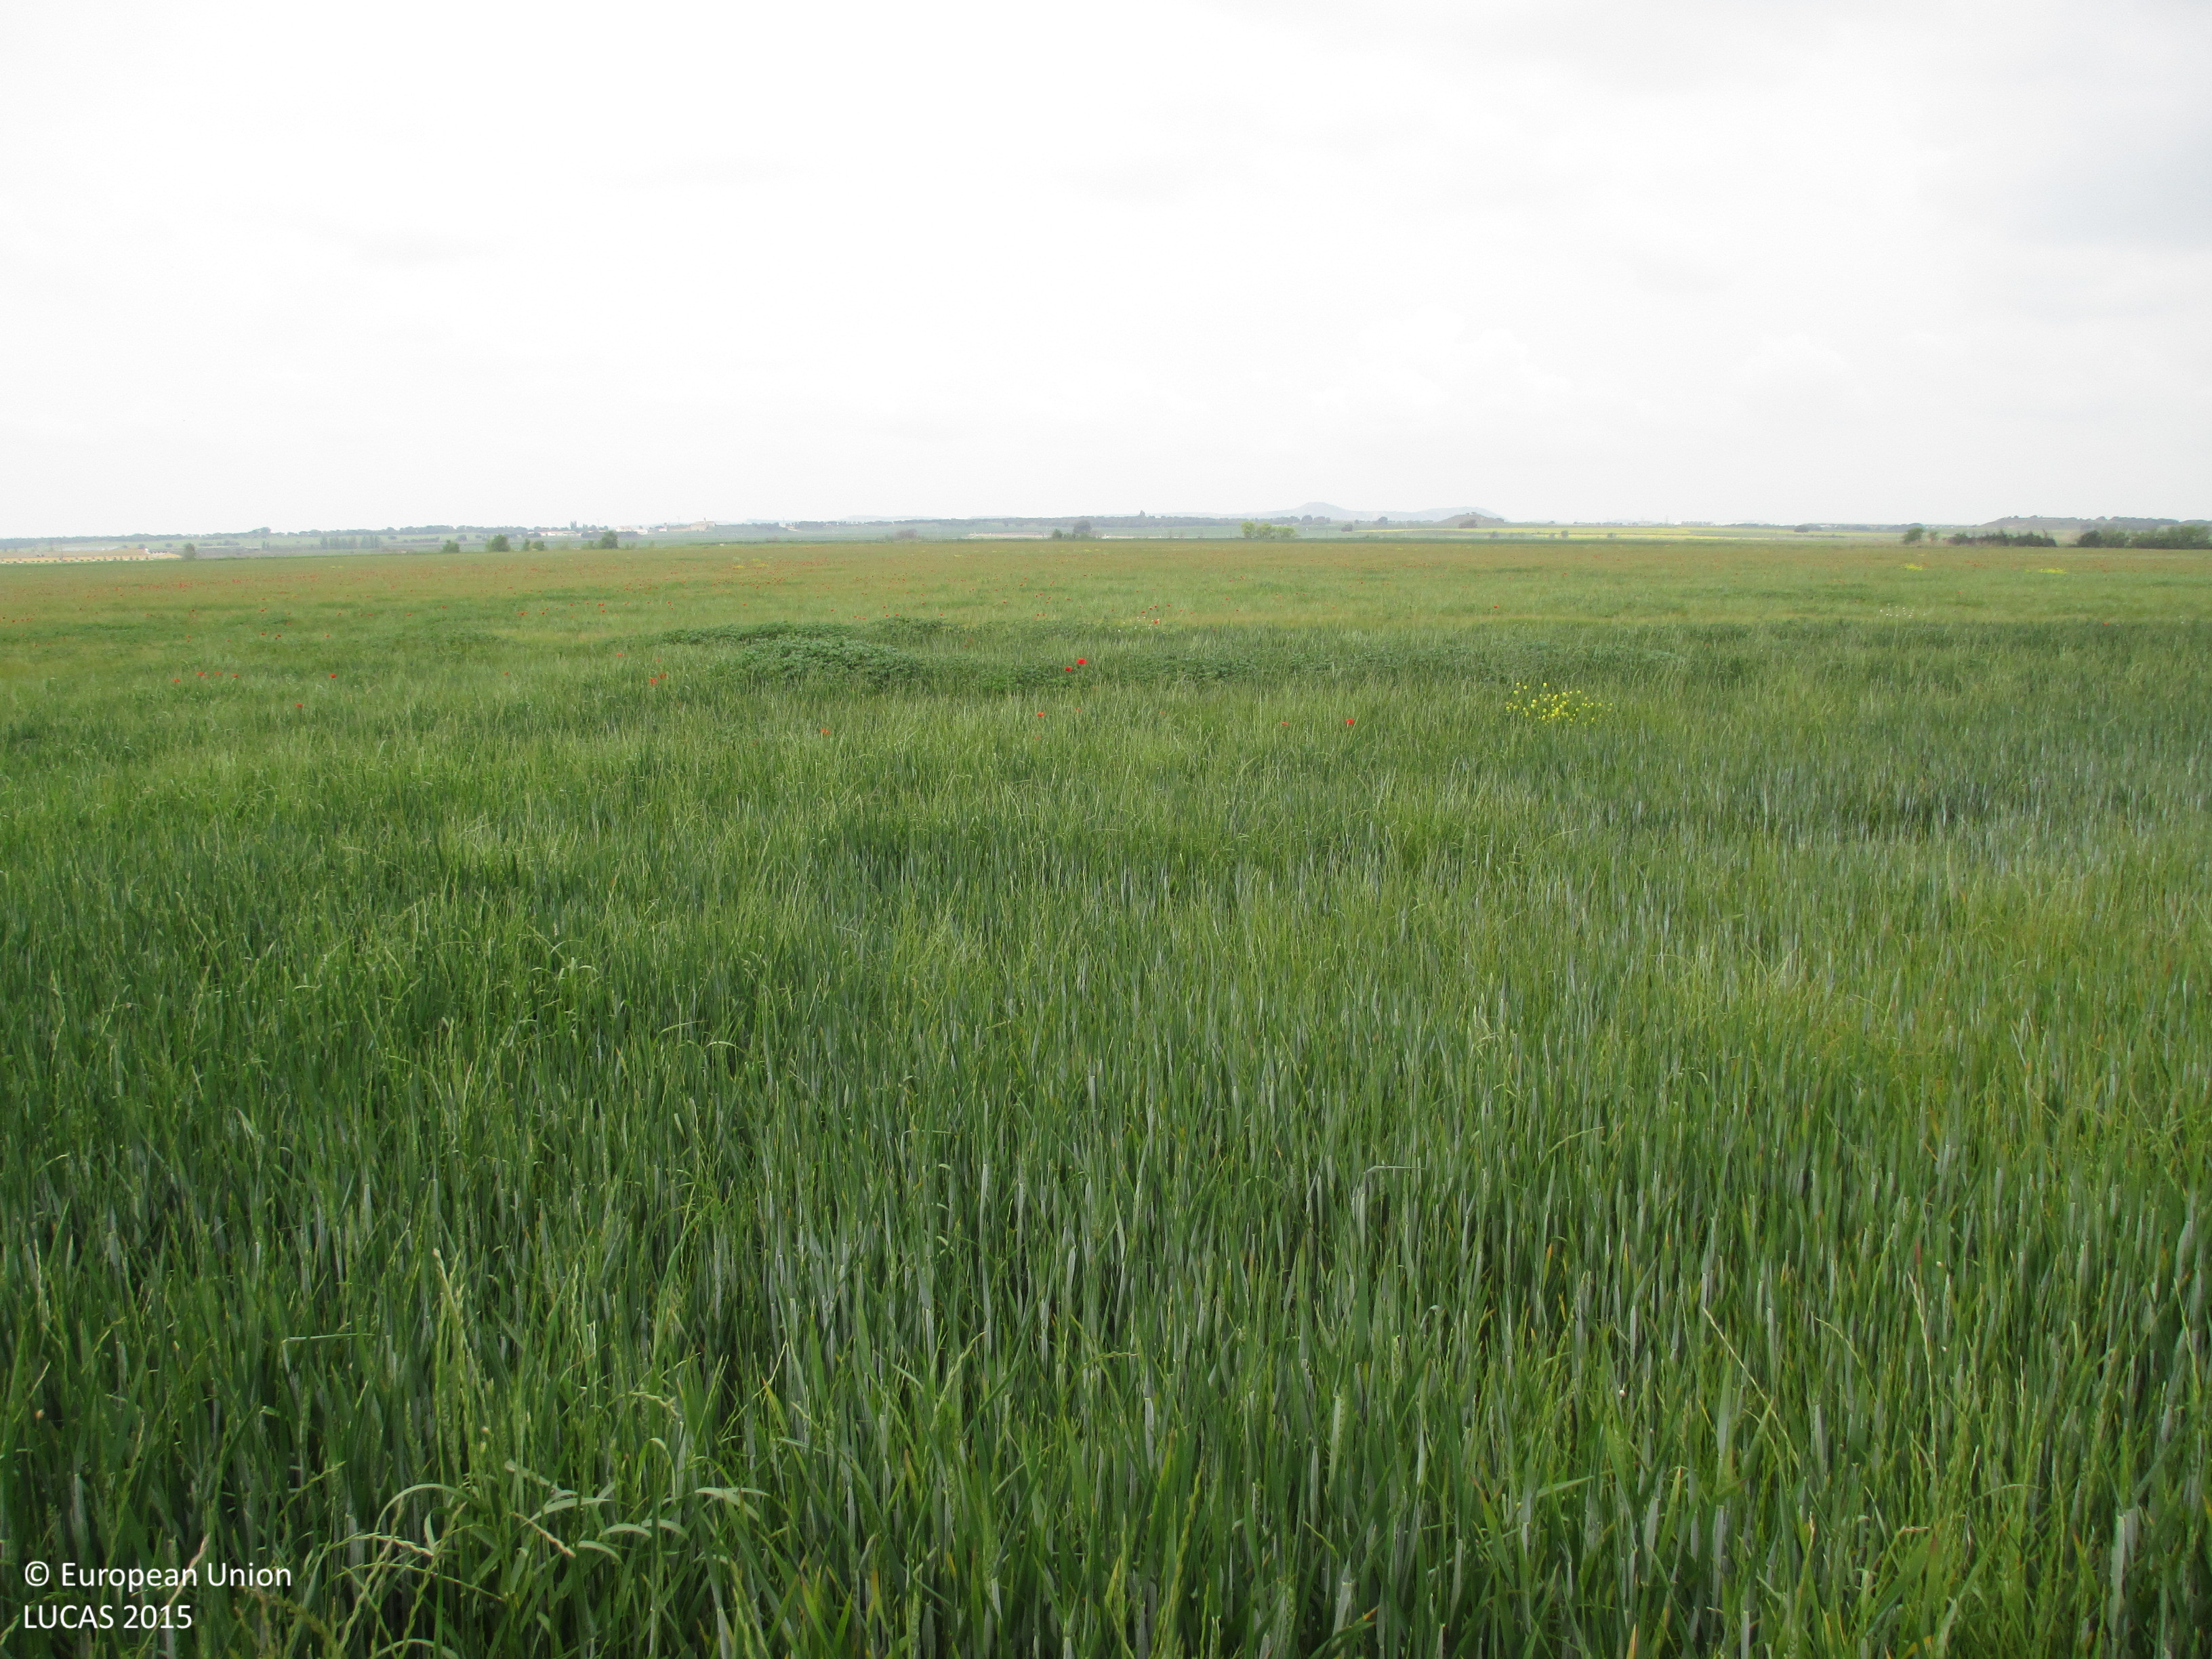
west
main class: Cropland
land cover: Durum wheat
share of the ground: > 75 %
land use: Agriculture (excluding fallow land and kitchen gardens)
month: April
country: ES
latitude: 42.0981
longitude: -0.4087
